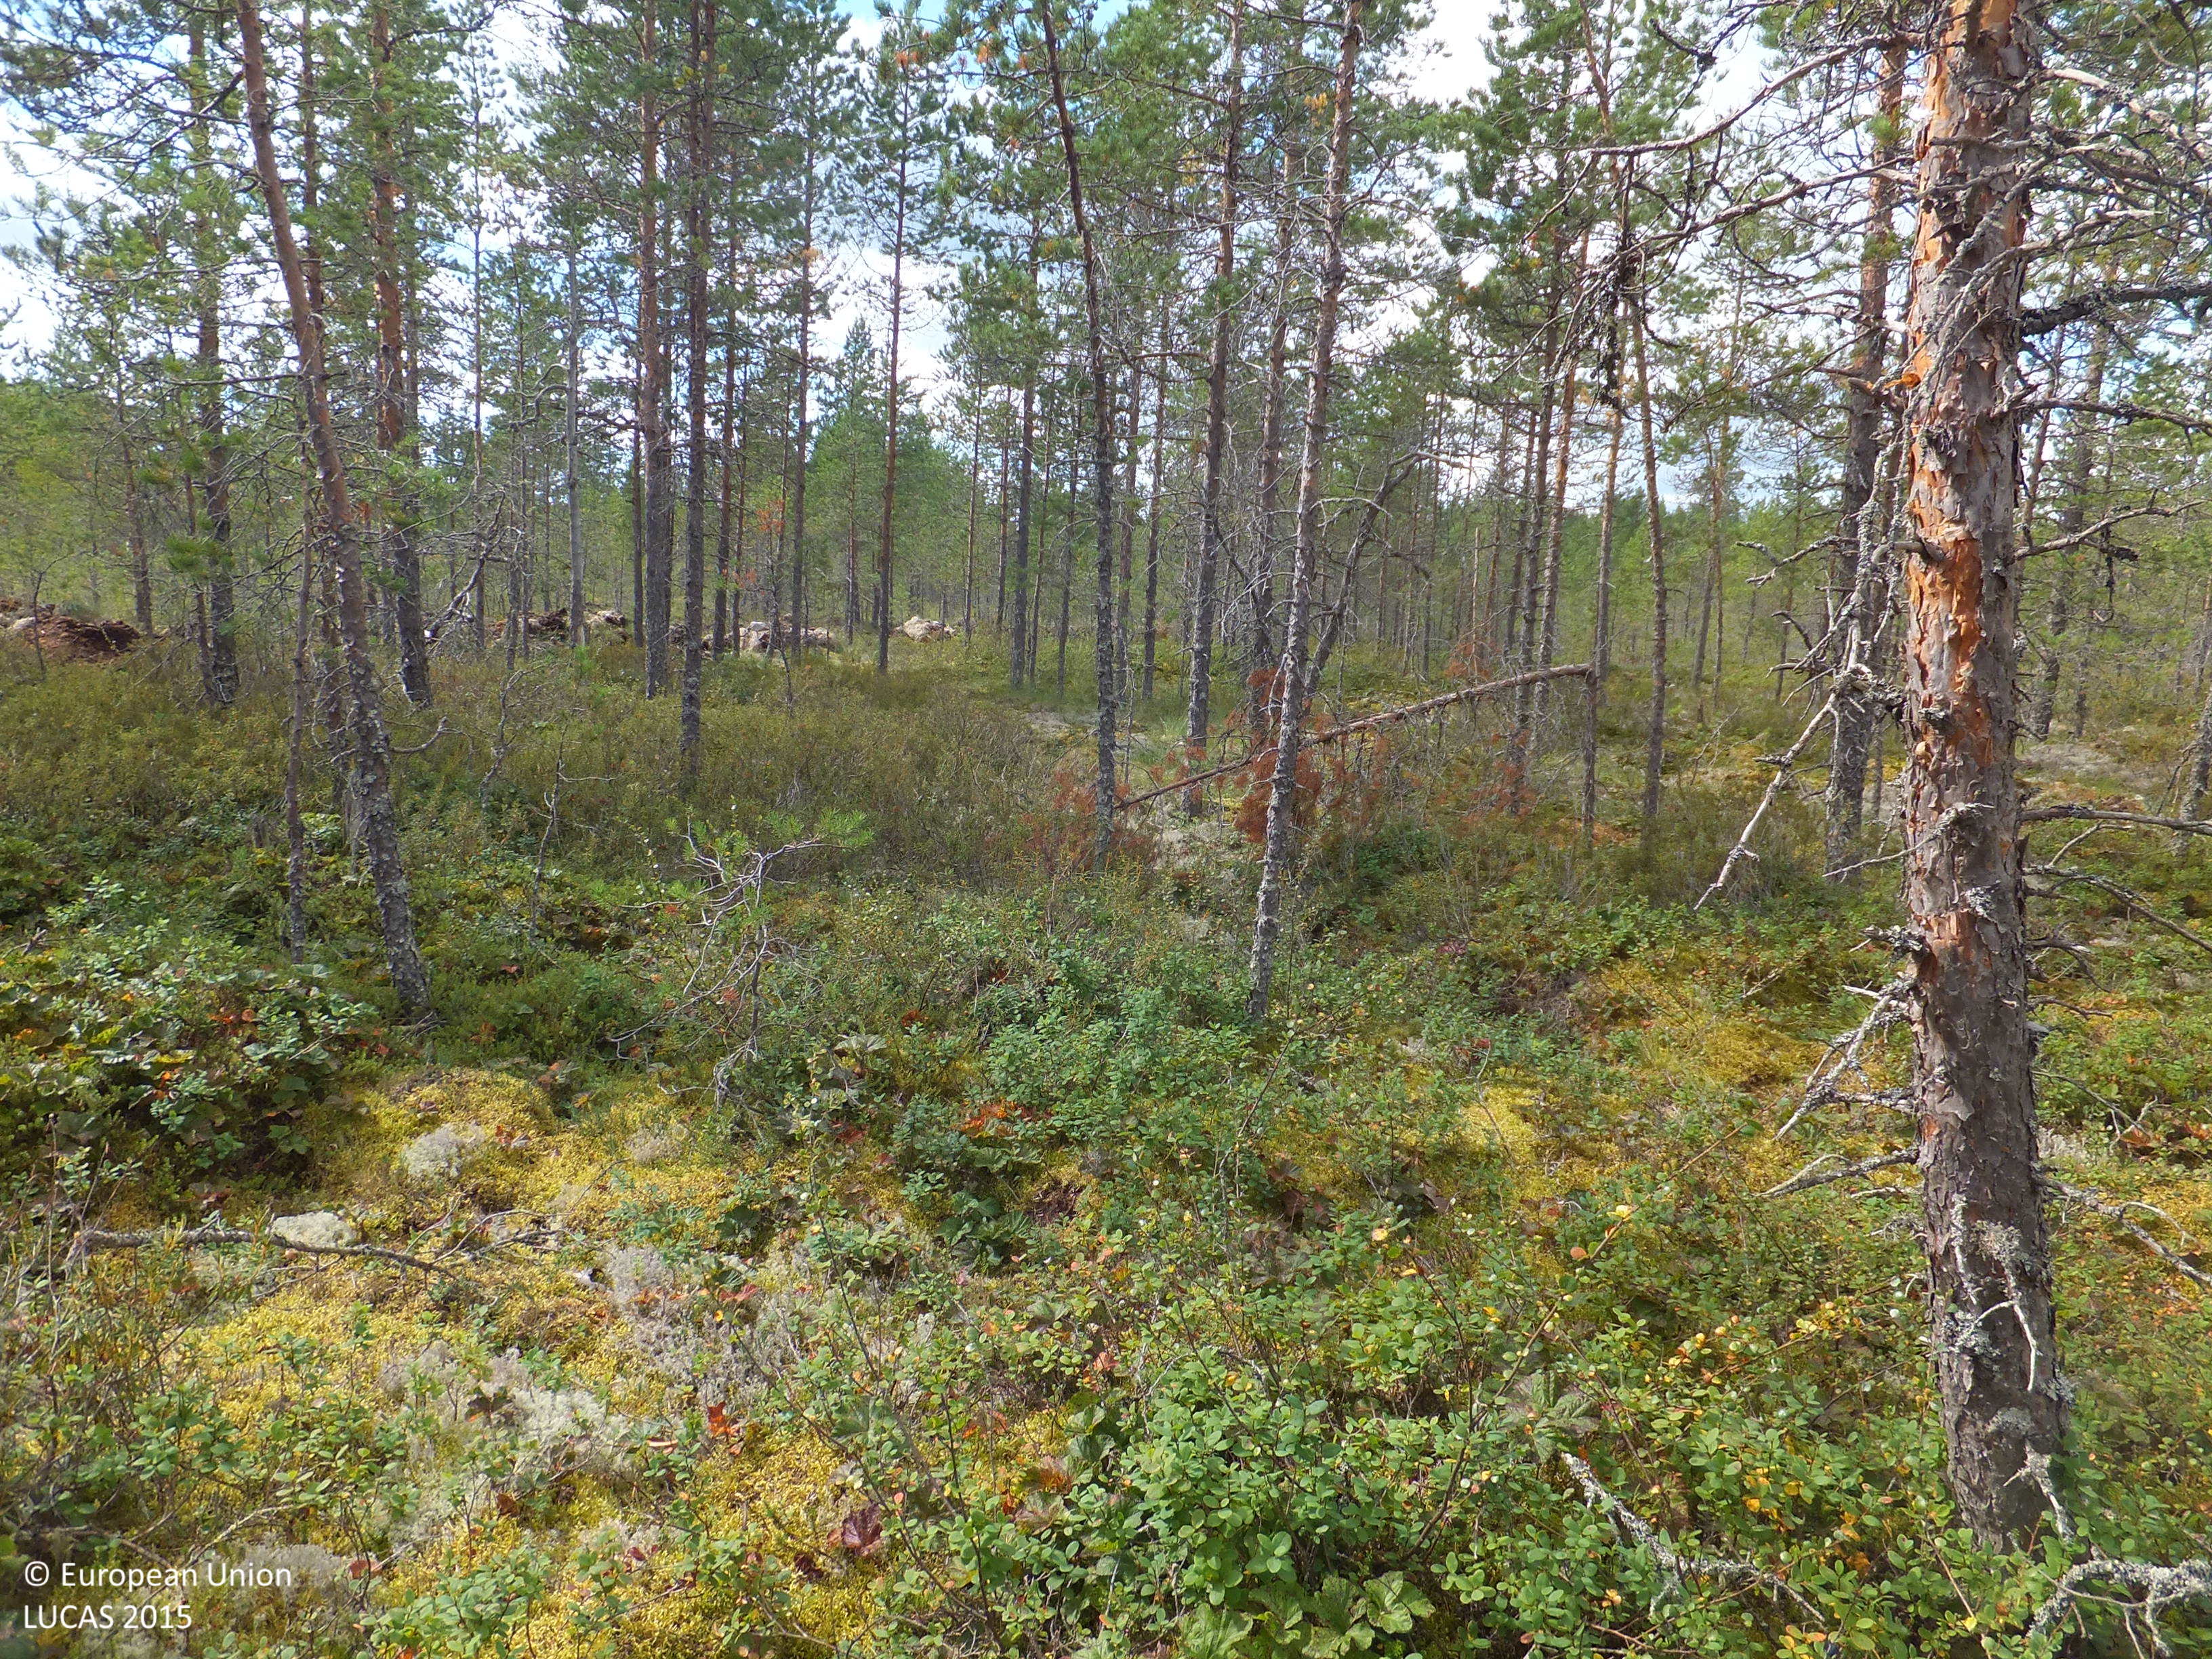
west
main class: Woodland
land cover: Pine dominated coniferous woodland
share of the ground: 25 - 50 %
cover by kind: coniferous forest trees 45 %, shrubs 25 %, lichens and mosses 20 %, herbaceous plants 10 %
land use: Forestry
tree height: < 5 m
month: August
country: FI
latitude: 63.2726
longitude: 23.4359
